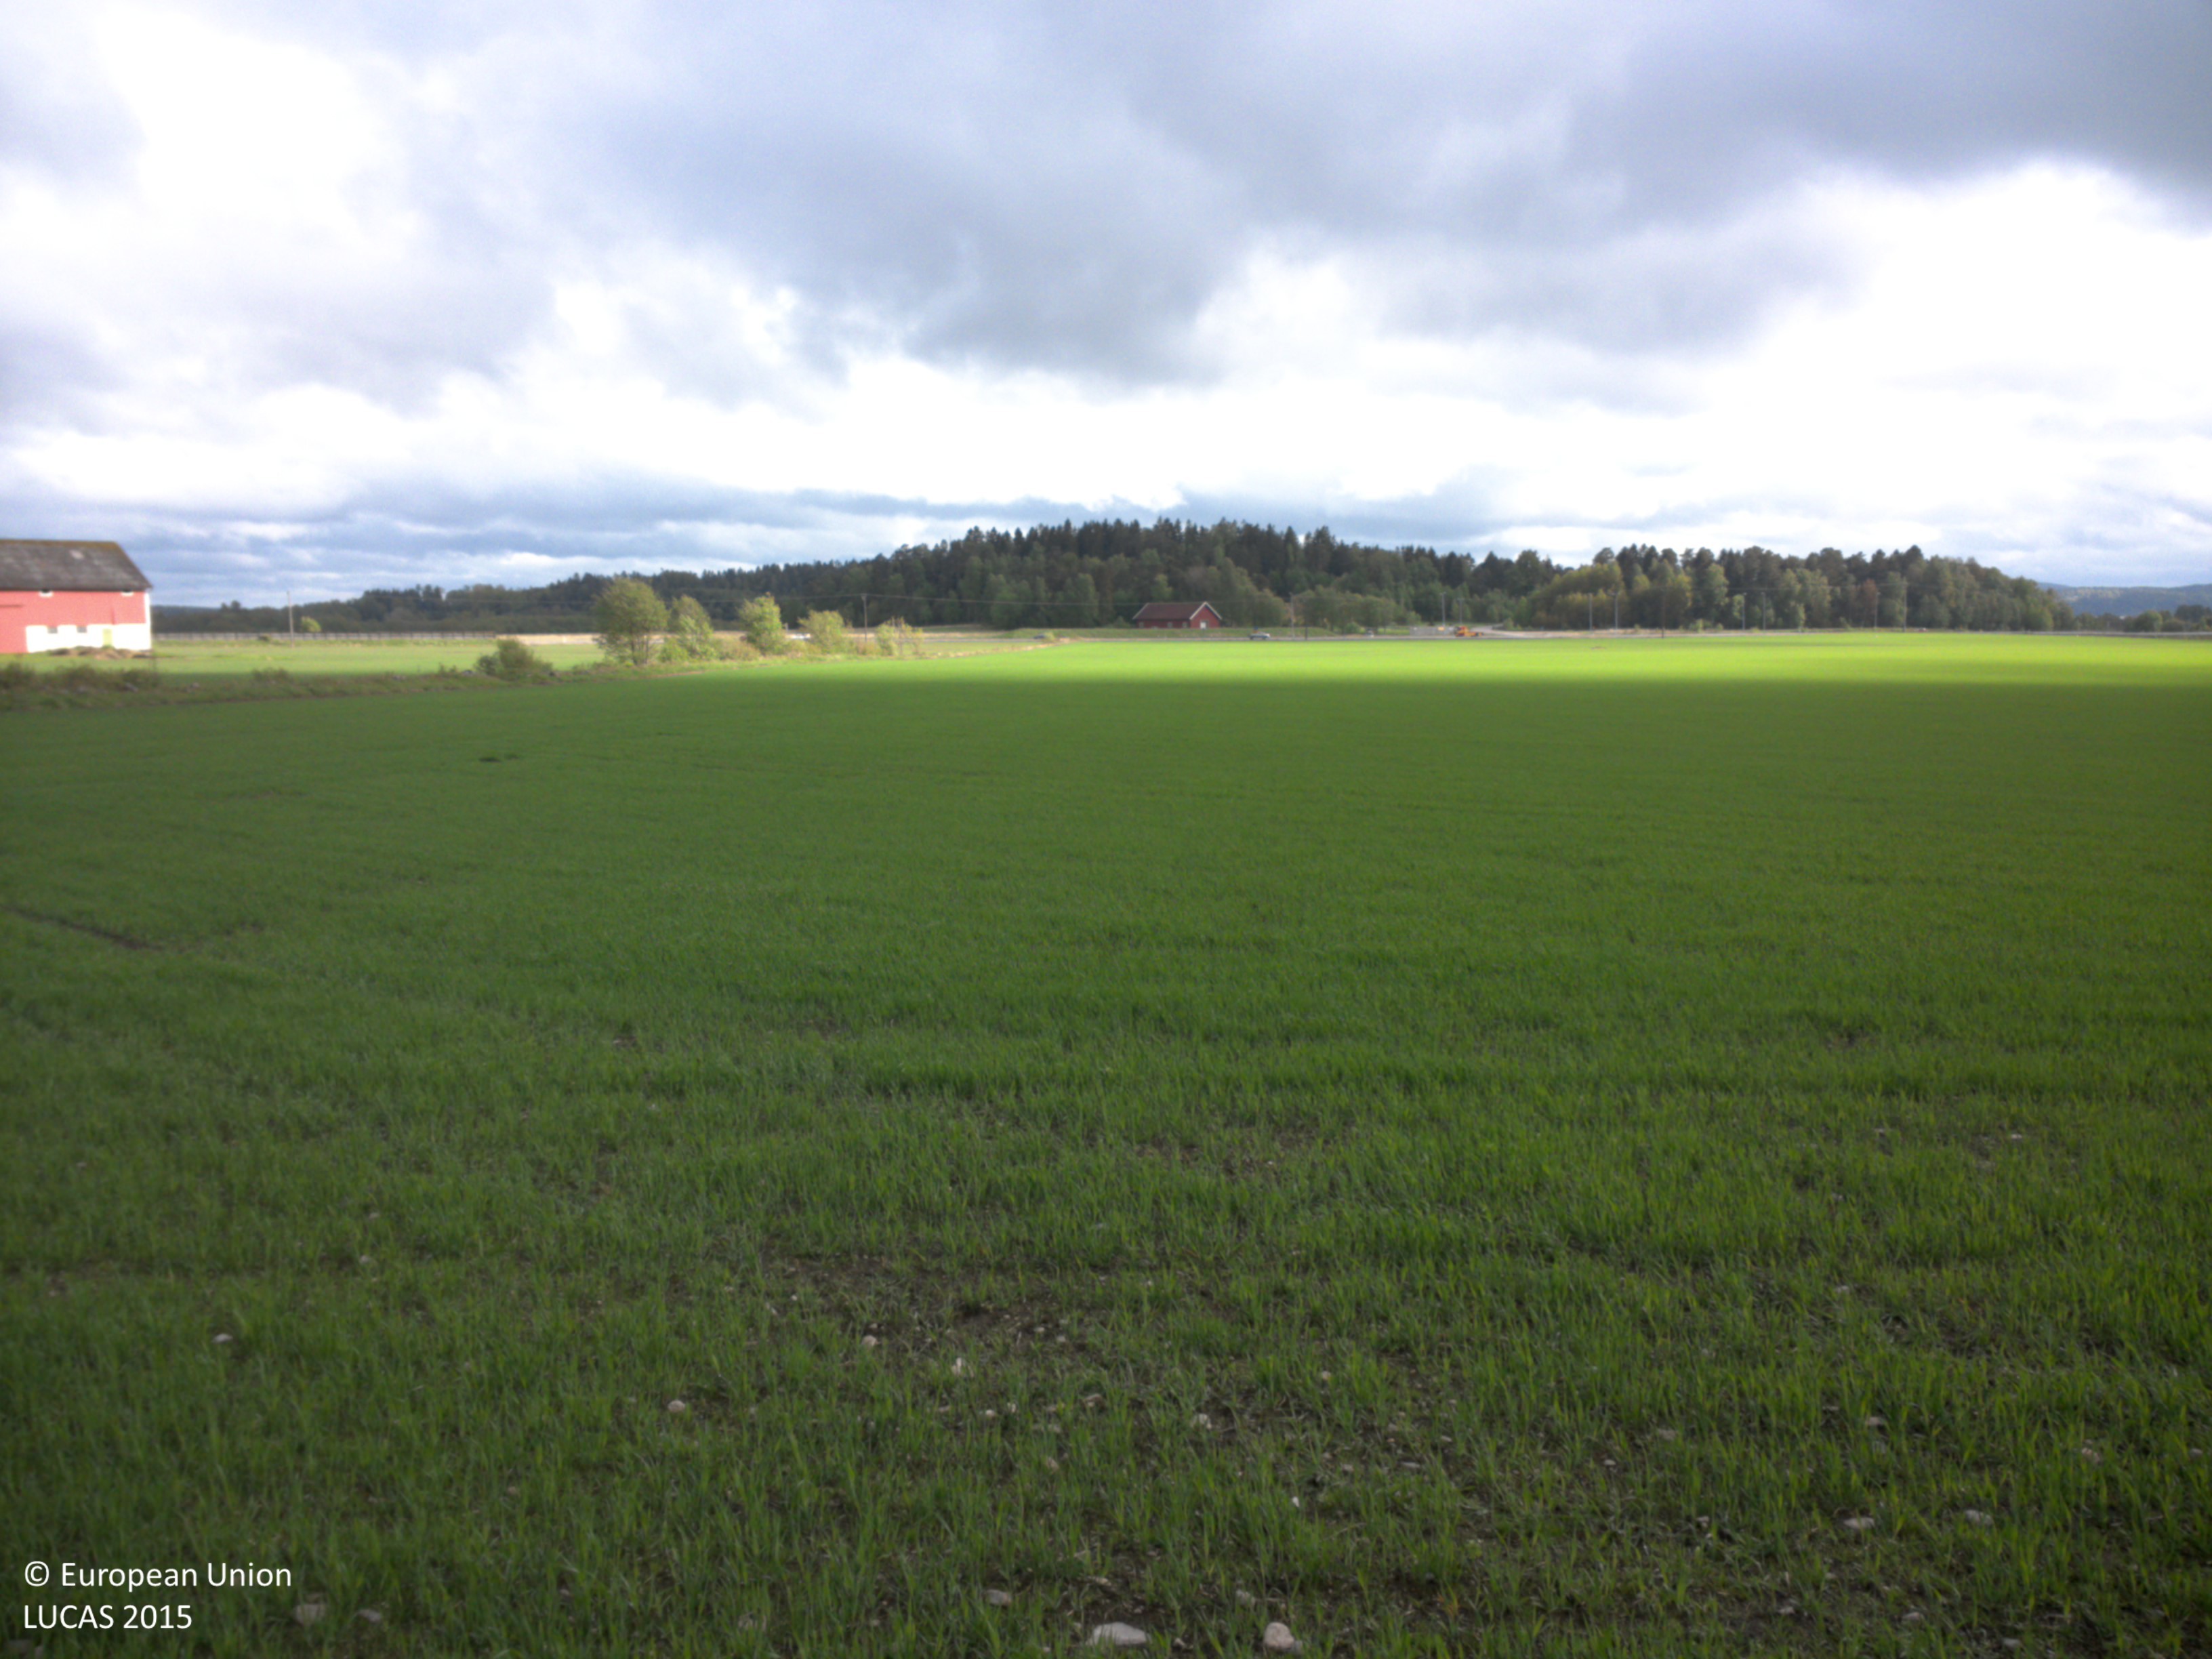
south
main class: Cropland
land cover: Common wheat
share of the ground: 50 - 75 %
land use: Agriculture (excluding fallow land and kitchen gardens)
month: May
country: SE
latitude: 58.3515
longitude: 11.7905
